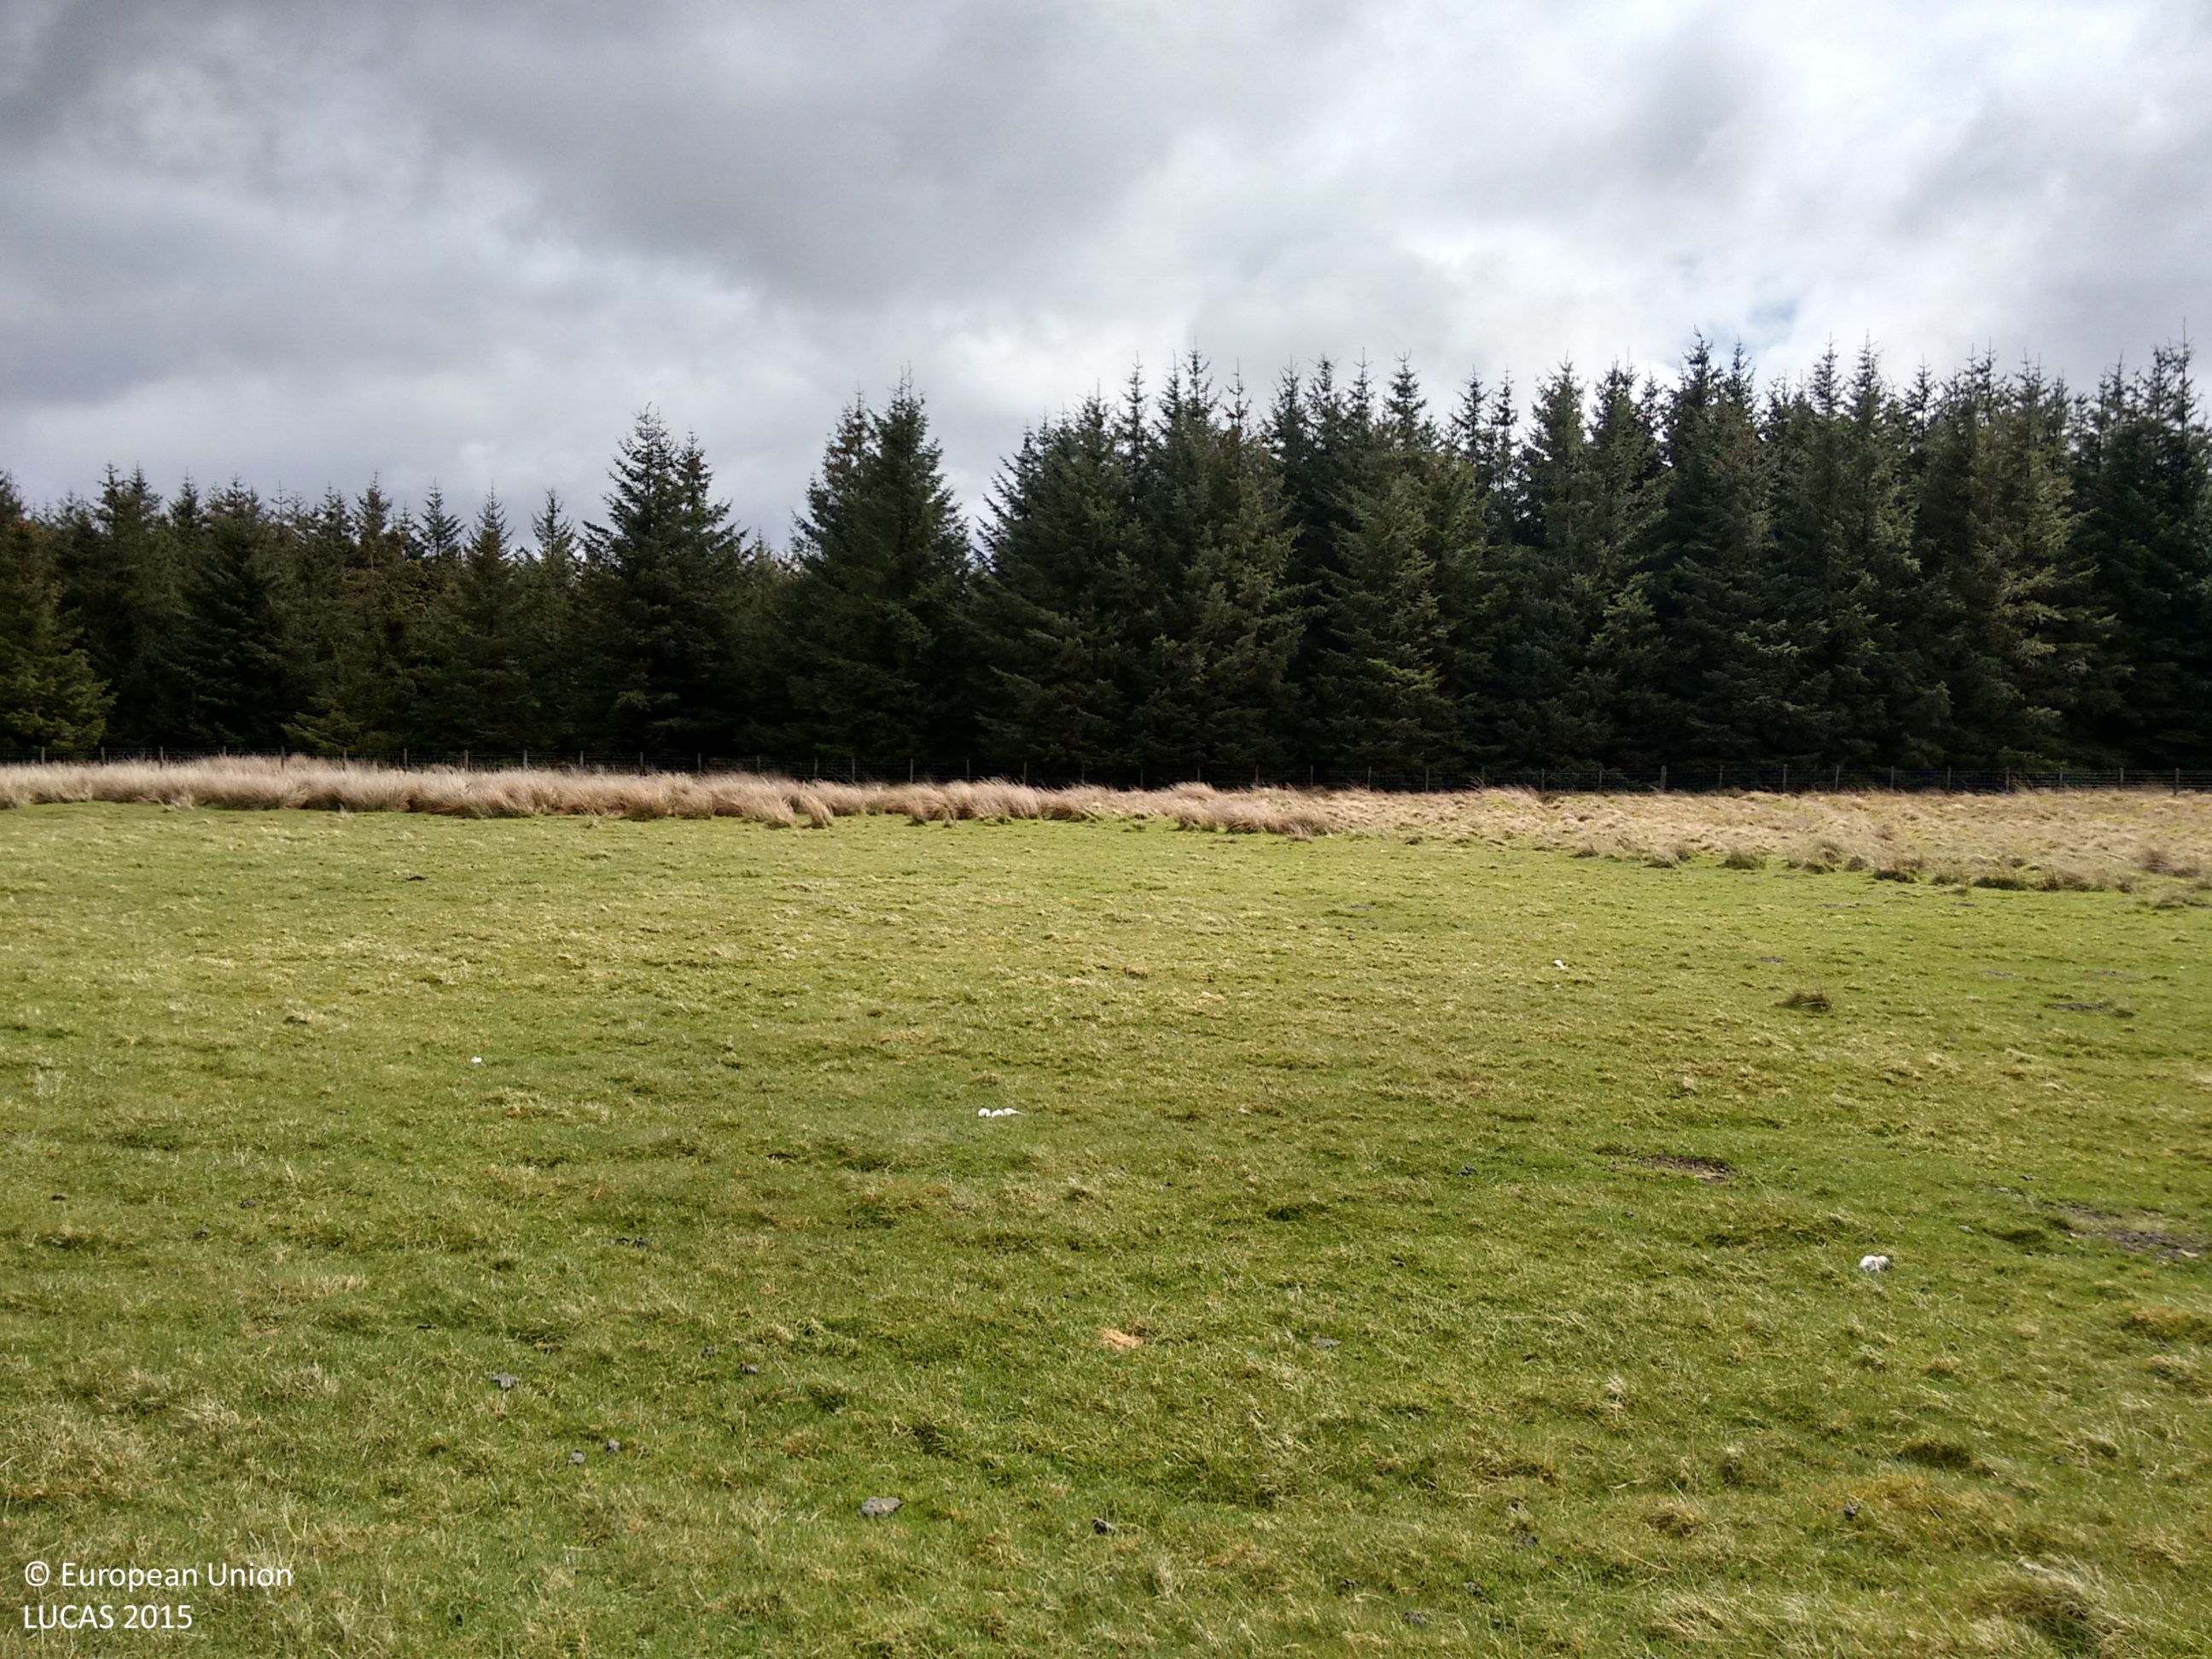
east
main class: Grassland
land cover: Grassland without tree/shrub cover
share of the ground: > 75 %
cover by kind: herbaceous plants 100 %
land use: Agriculture (excluding fallow land and kitchen gardens)
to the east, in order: Grassland without tree/shrub cover; Fences; Spruce dominated coniferous woodland
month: May
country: GB
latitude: 55.7763
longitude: -3.1930
